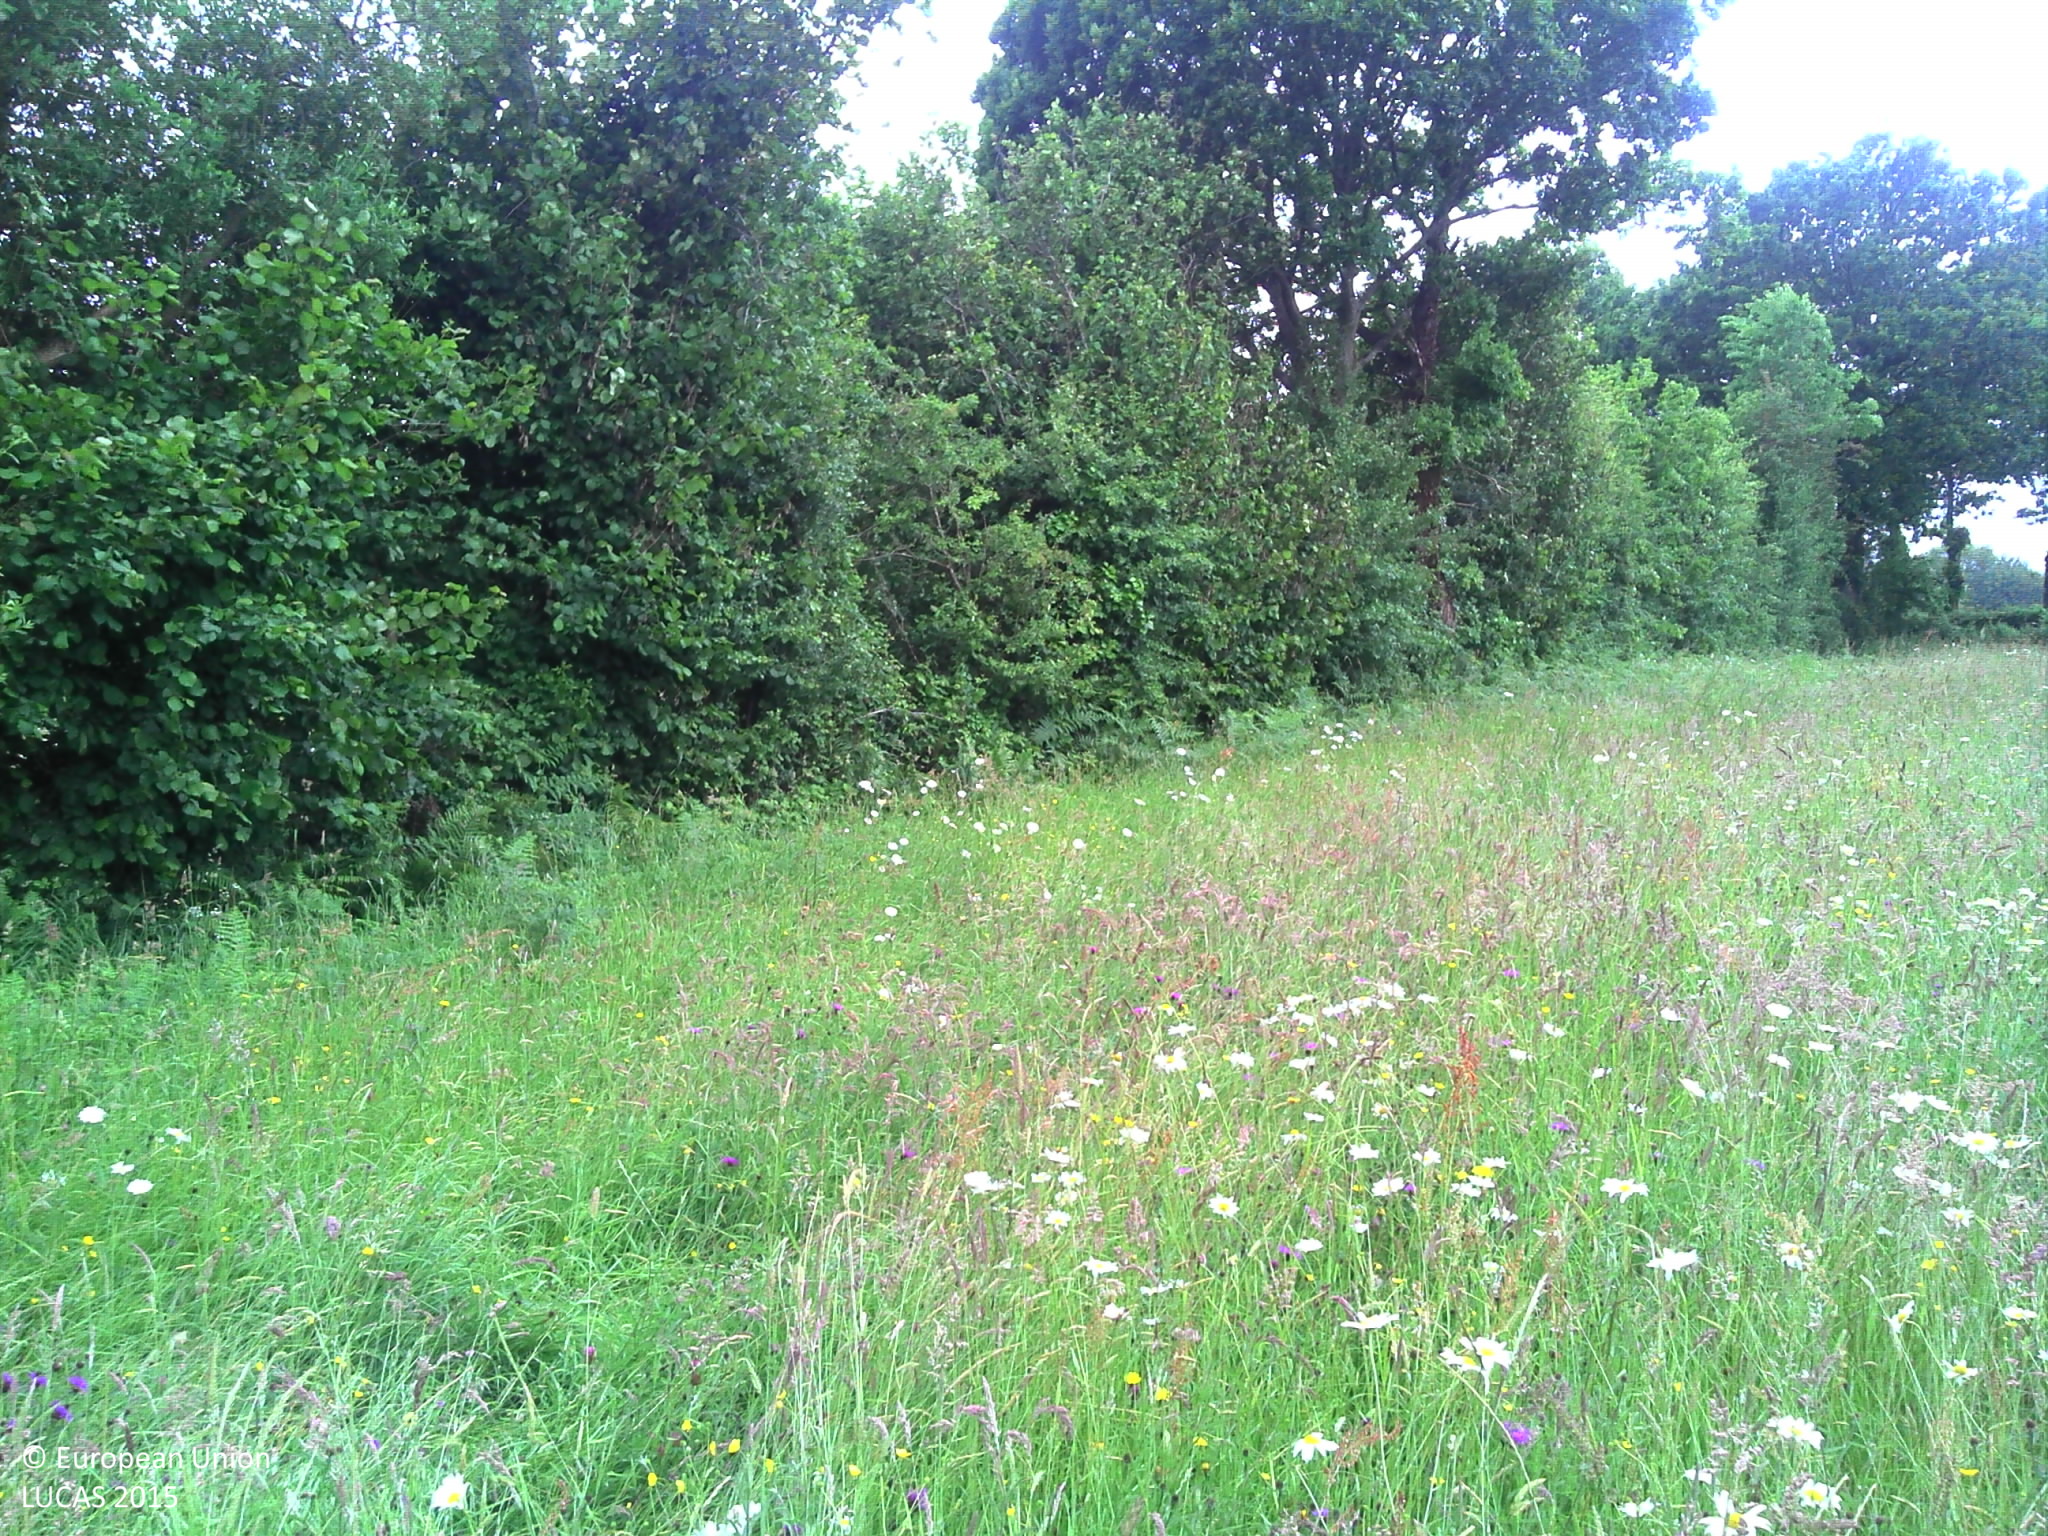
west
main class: Grassland
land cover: Grassland without tree/shrub cover
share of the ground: > 75 %
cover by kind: herbaceous plants 100 %
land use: Agriculture (excluding fallow land and kitchen gardens)
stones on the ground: < 10 %
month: June
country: FR
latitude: 49.3648
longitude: -1.4919
